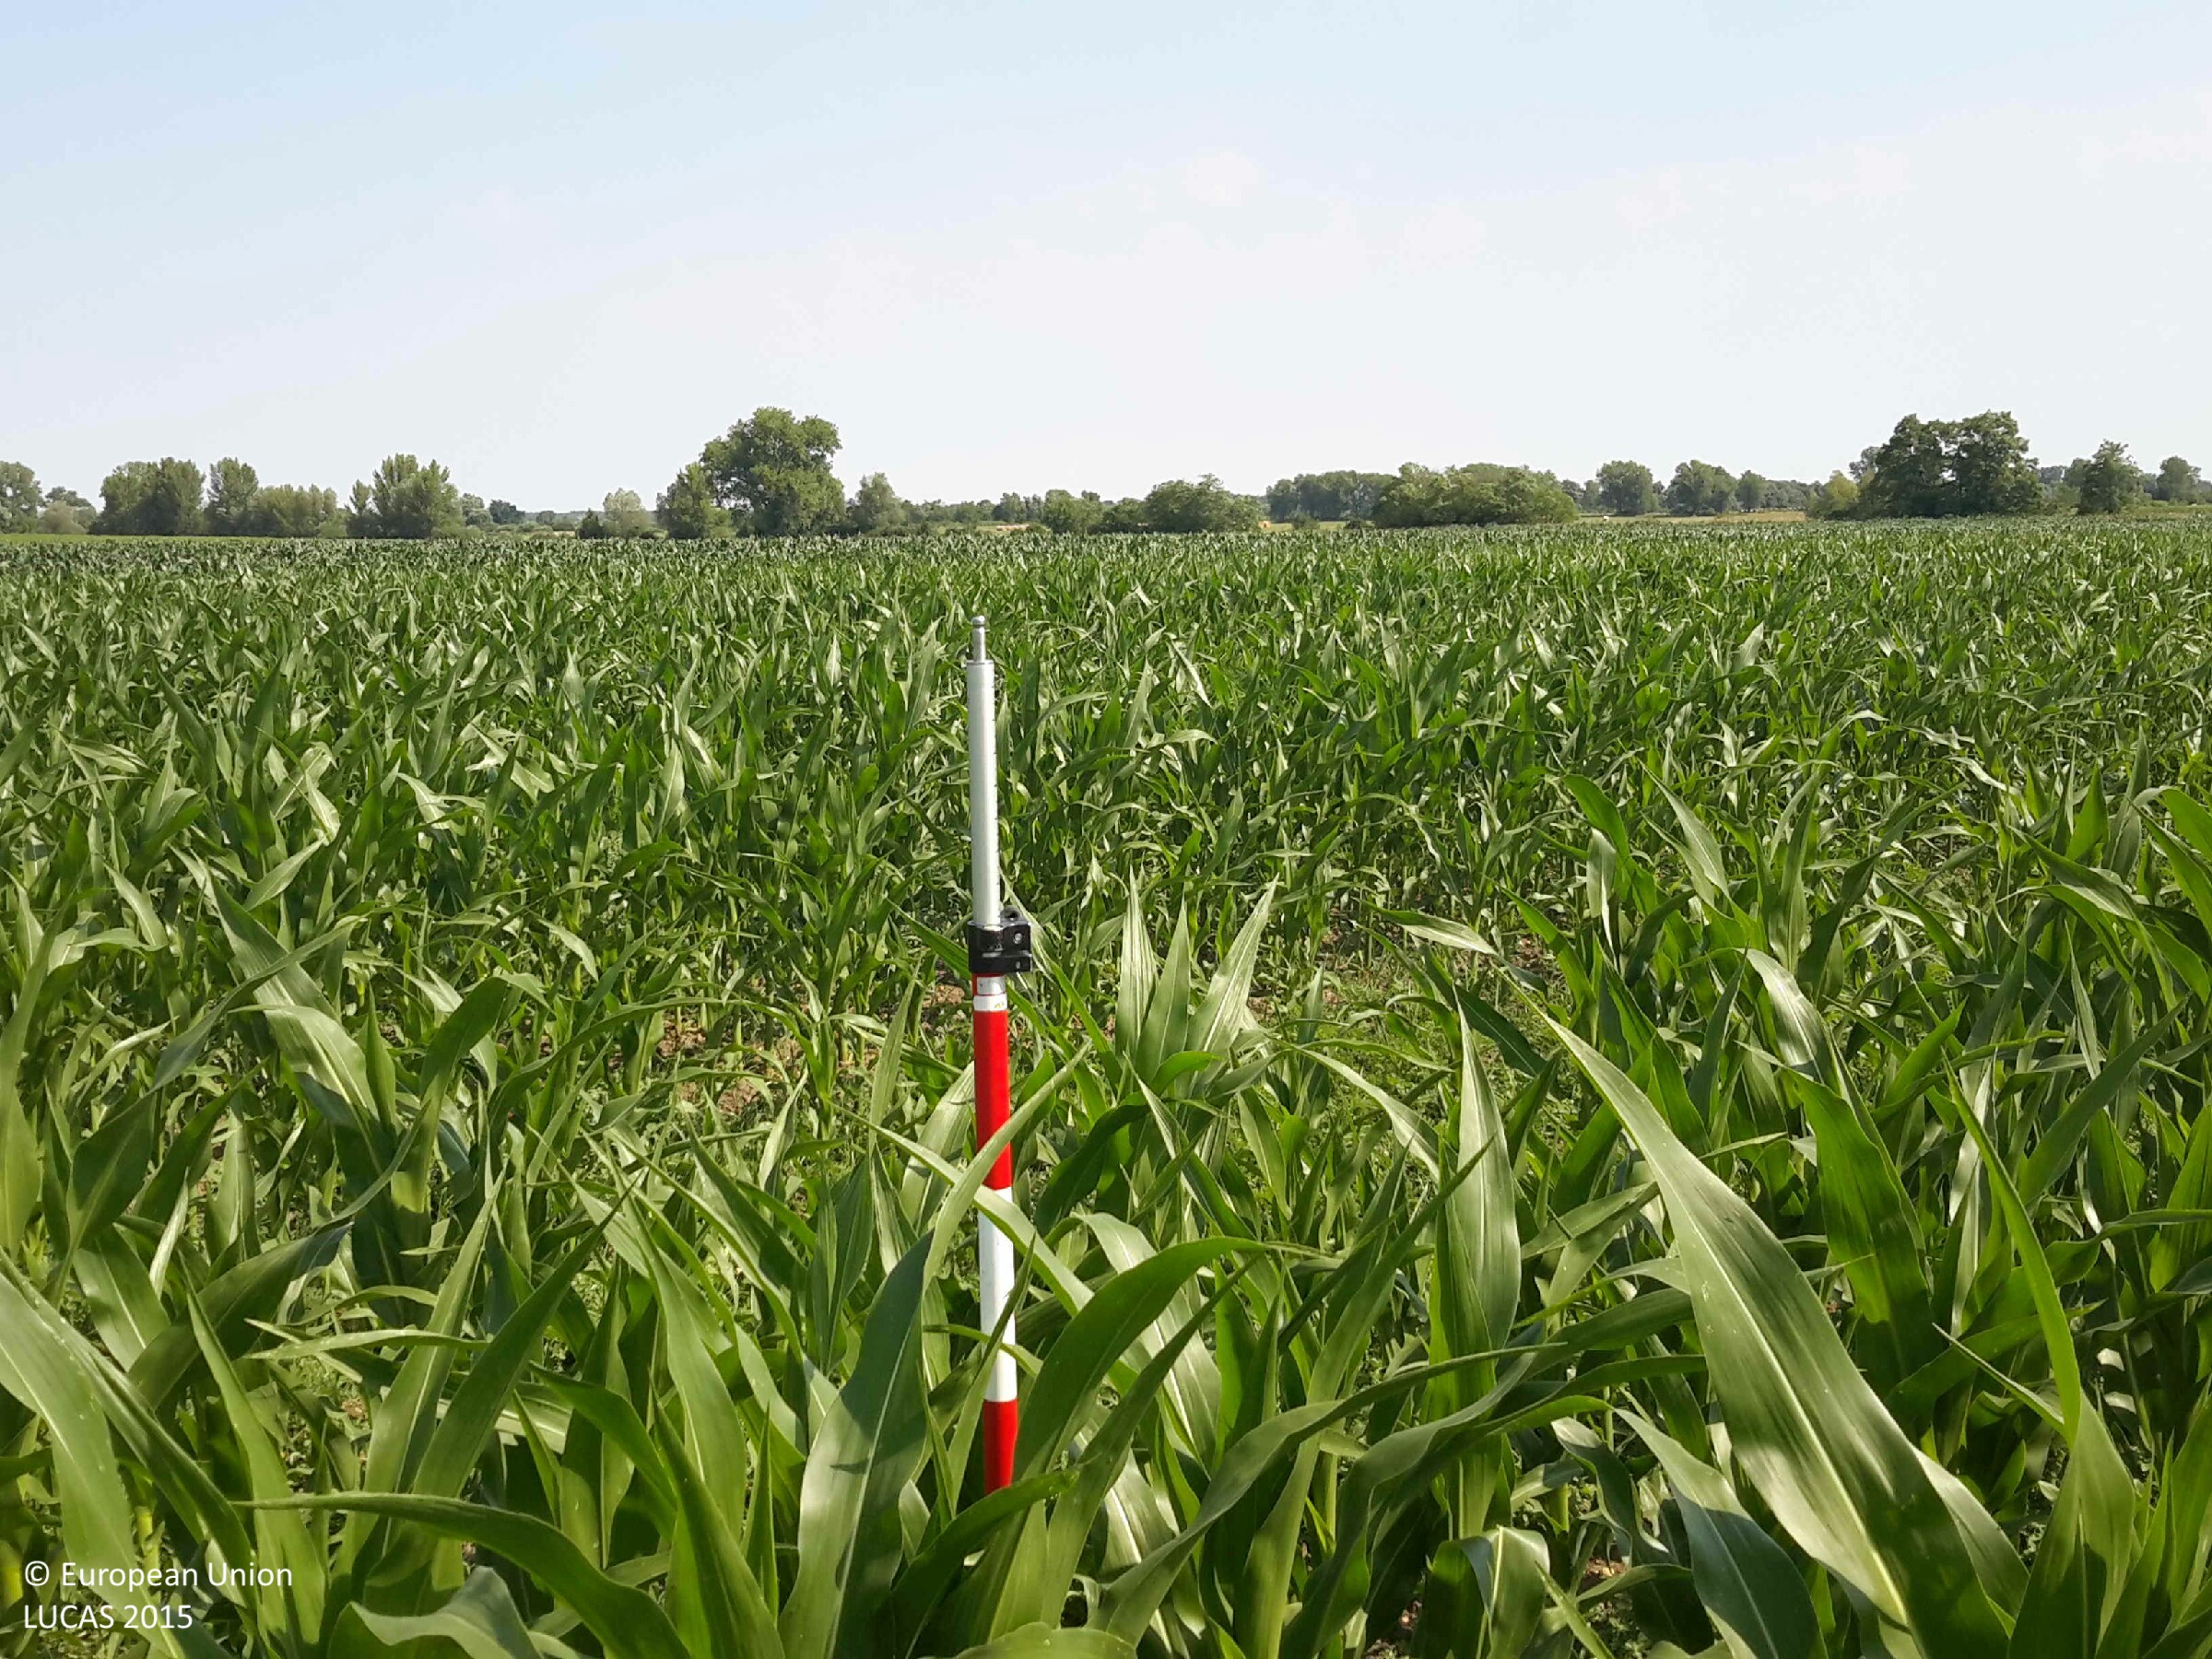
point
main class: Cropland
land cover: Maize
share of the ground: > 75 %
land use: Agriculture (excluding fallow land and kitchen gardens)
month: July
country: HU
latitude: 47.3668
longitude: 17.3030
